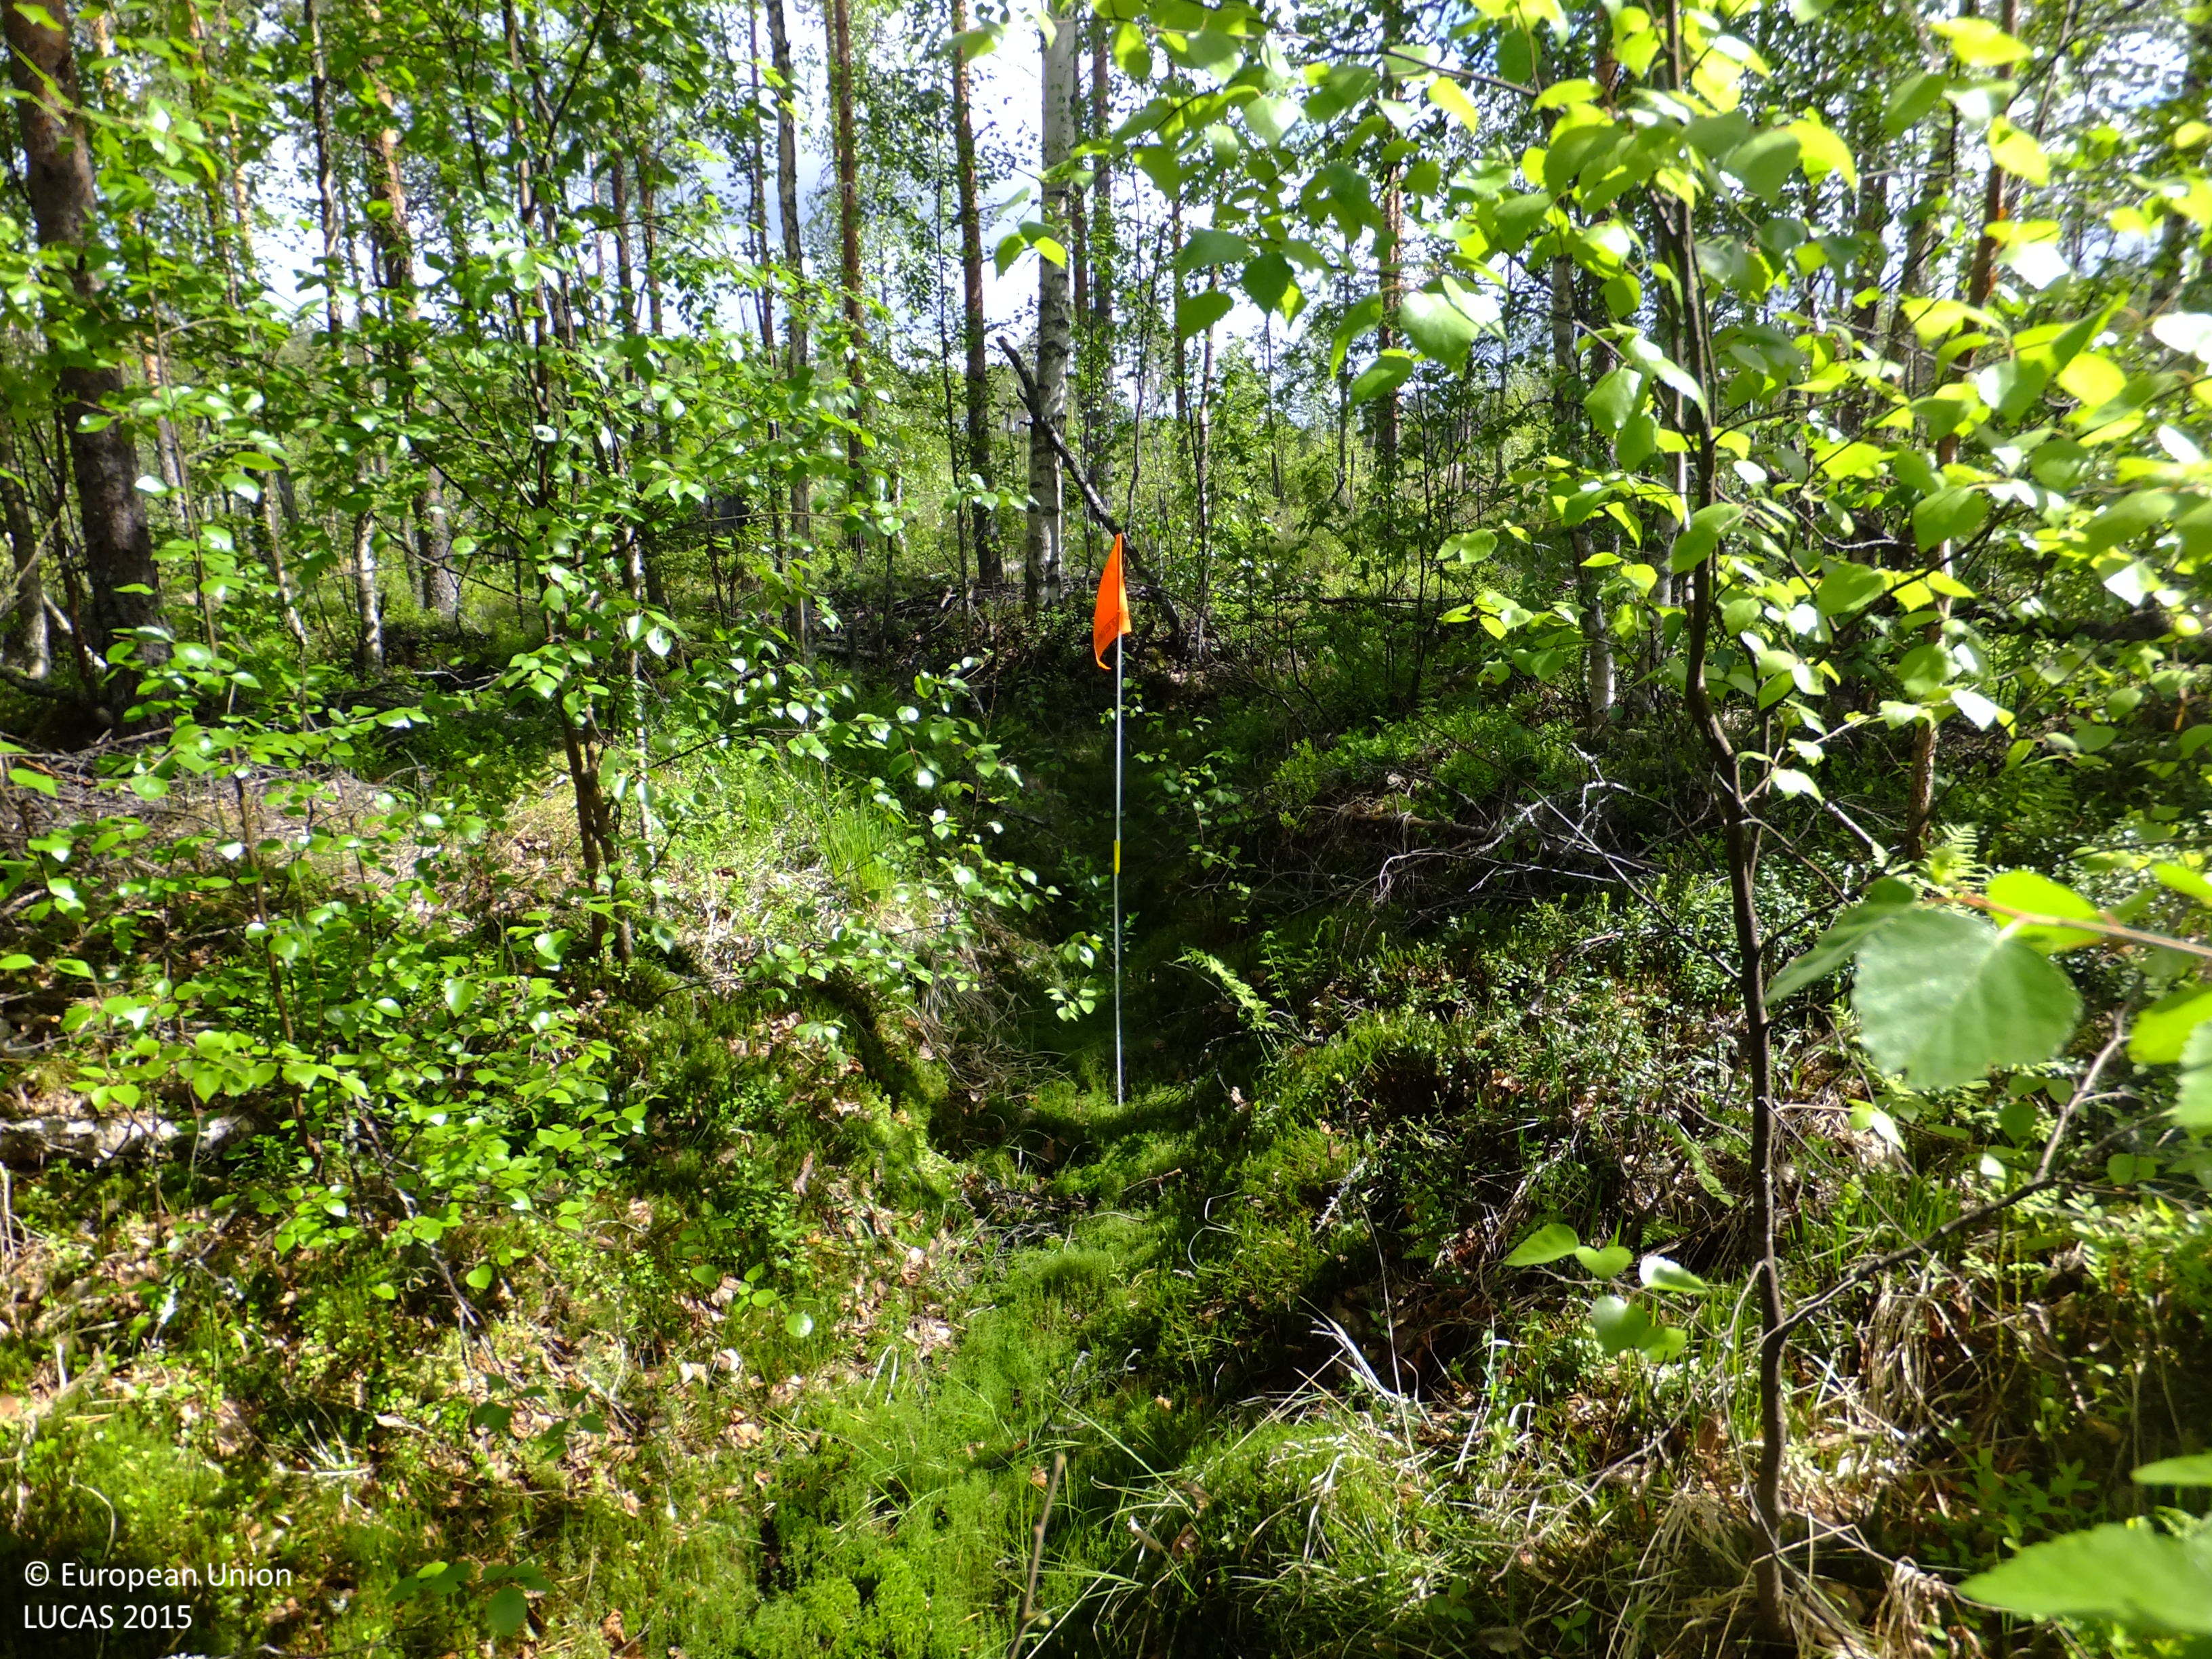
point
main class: Woodland
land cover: Pine dominated coniferous woodland
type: boreal forest
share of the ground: > 75 %
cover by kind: coniferous forest trees 65 %, broadleaved forest trees 15 %, herbaceous plants 10 %, shrubs 5 %, lichens and mosses 5 %
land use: Forestry
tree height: > 5 m
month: June
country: FI
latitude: 63.4800
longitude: 24.9643
